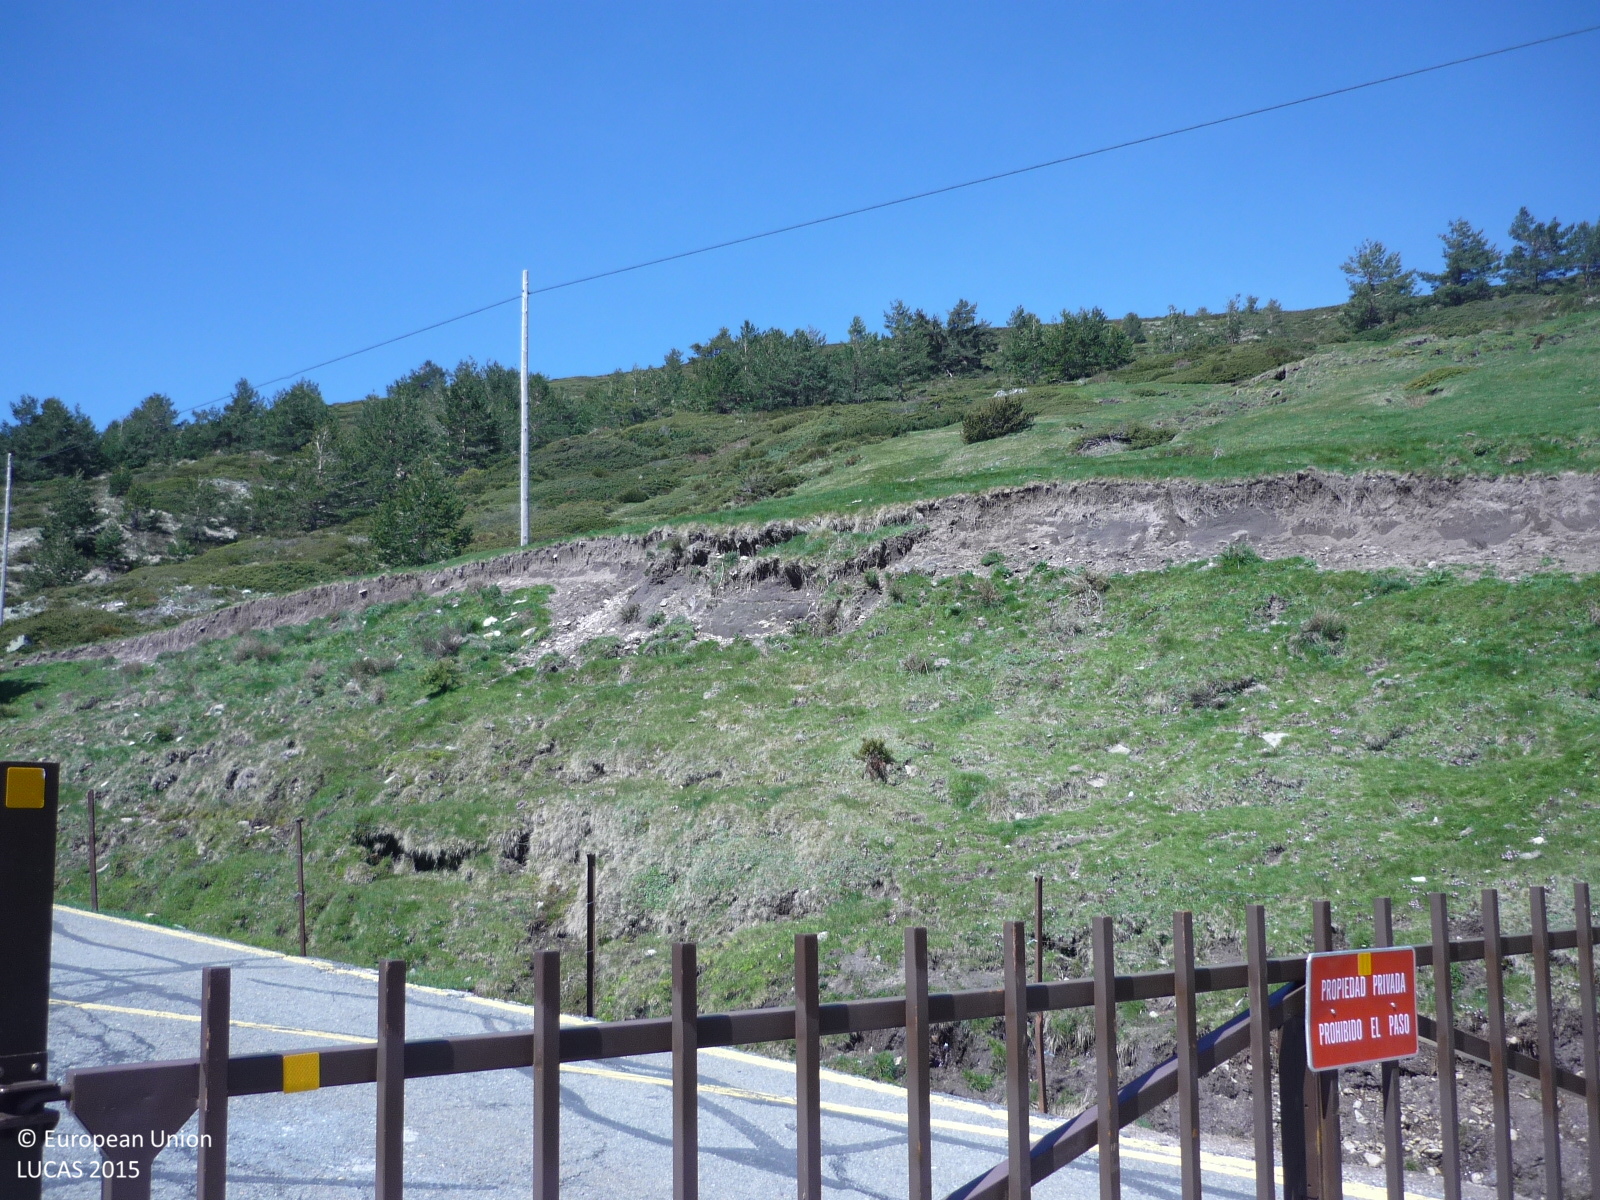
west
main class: Woodland
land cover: Pine dominated coniferous woodland
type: coniferous forest of the mediterranean region
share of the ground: > 75 %
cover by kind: coniferous forest trees 75 %, herbaceous plants 25 %
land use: Forestry
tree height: > 5 m
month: May
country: ES
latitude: 40.8045
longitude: -3.9502
